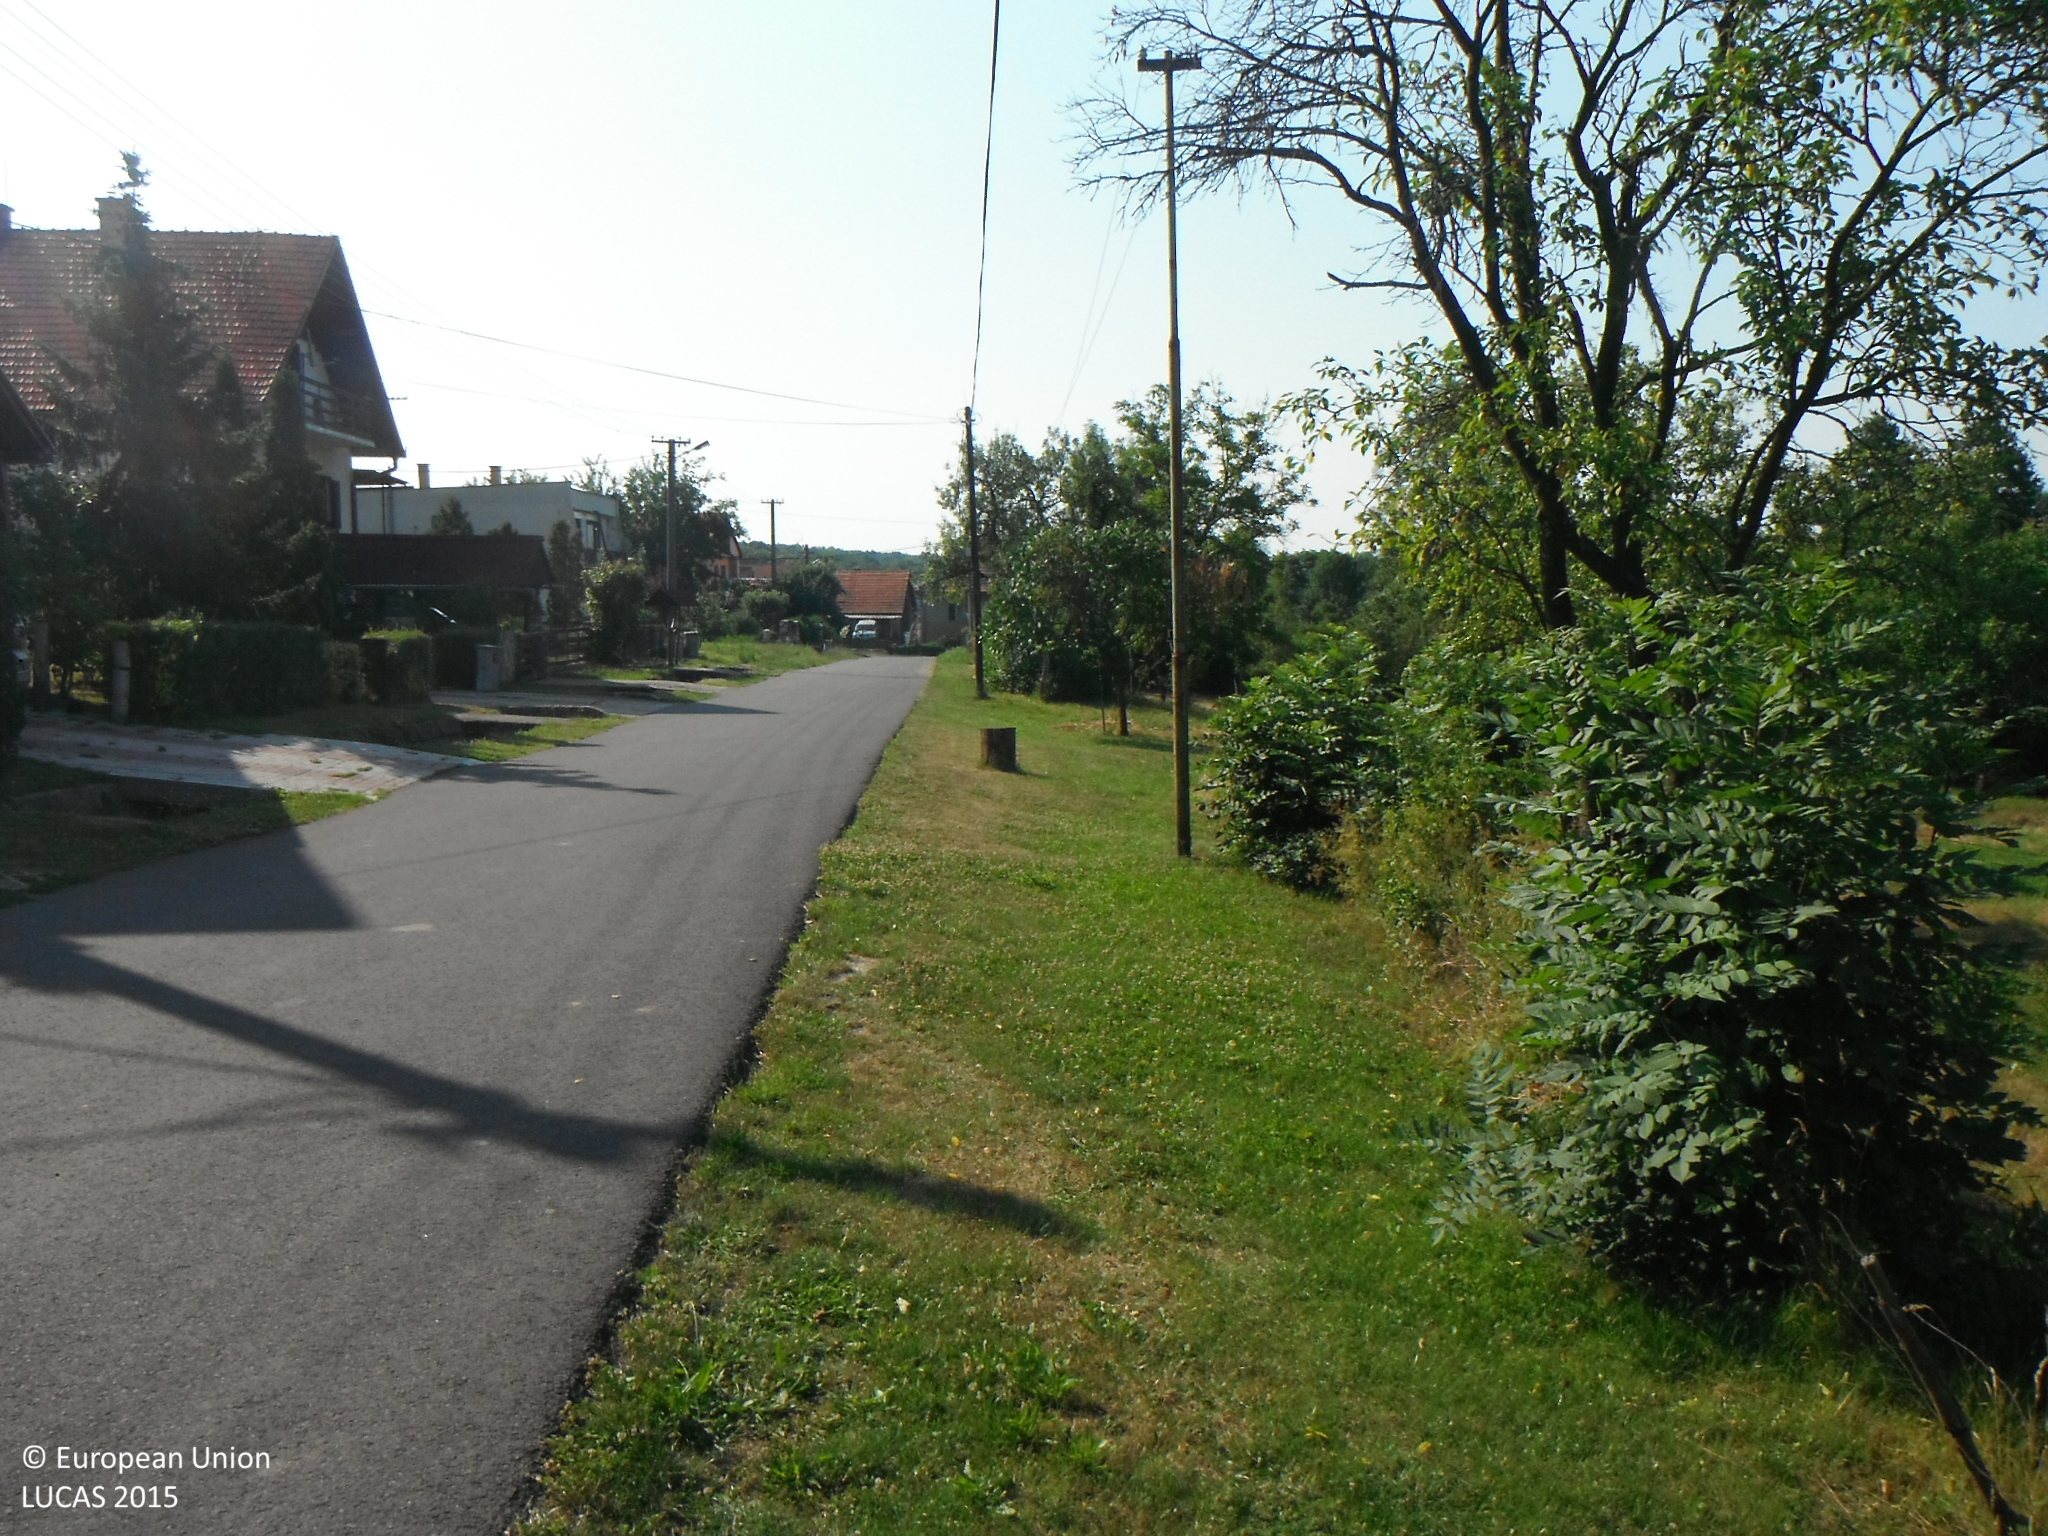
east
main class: Grassland
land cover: Grassland without tree/shrub cover
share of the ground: > 75 %
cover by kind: herbaceous plants 100 %
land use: Residential
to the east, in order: Grassland without tree/shrub cover; Artificial constructions in urban areas
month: July
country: SK
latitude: 48.1949
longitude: 19.2643
